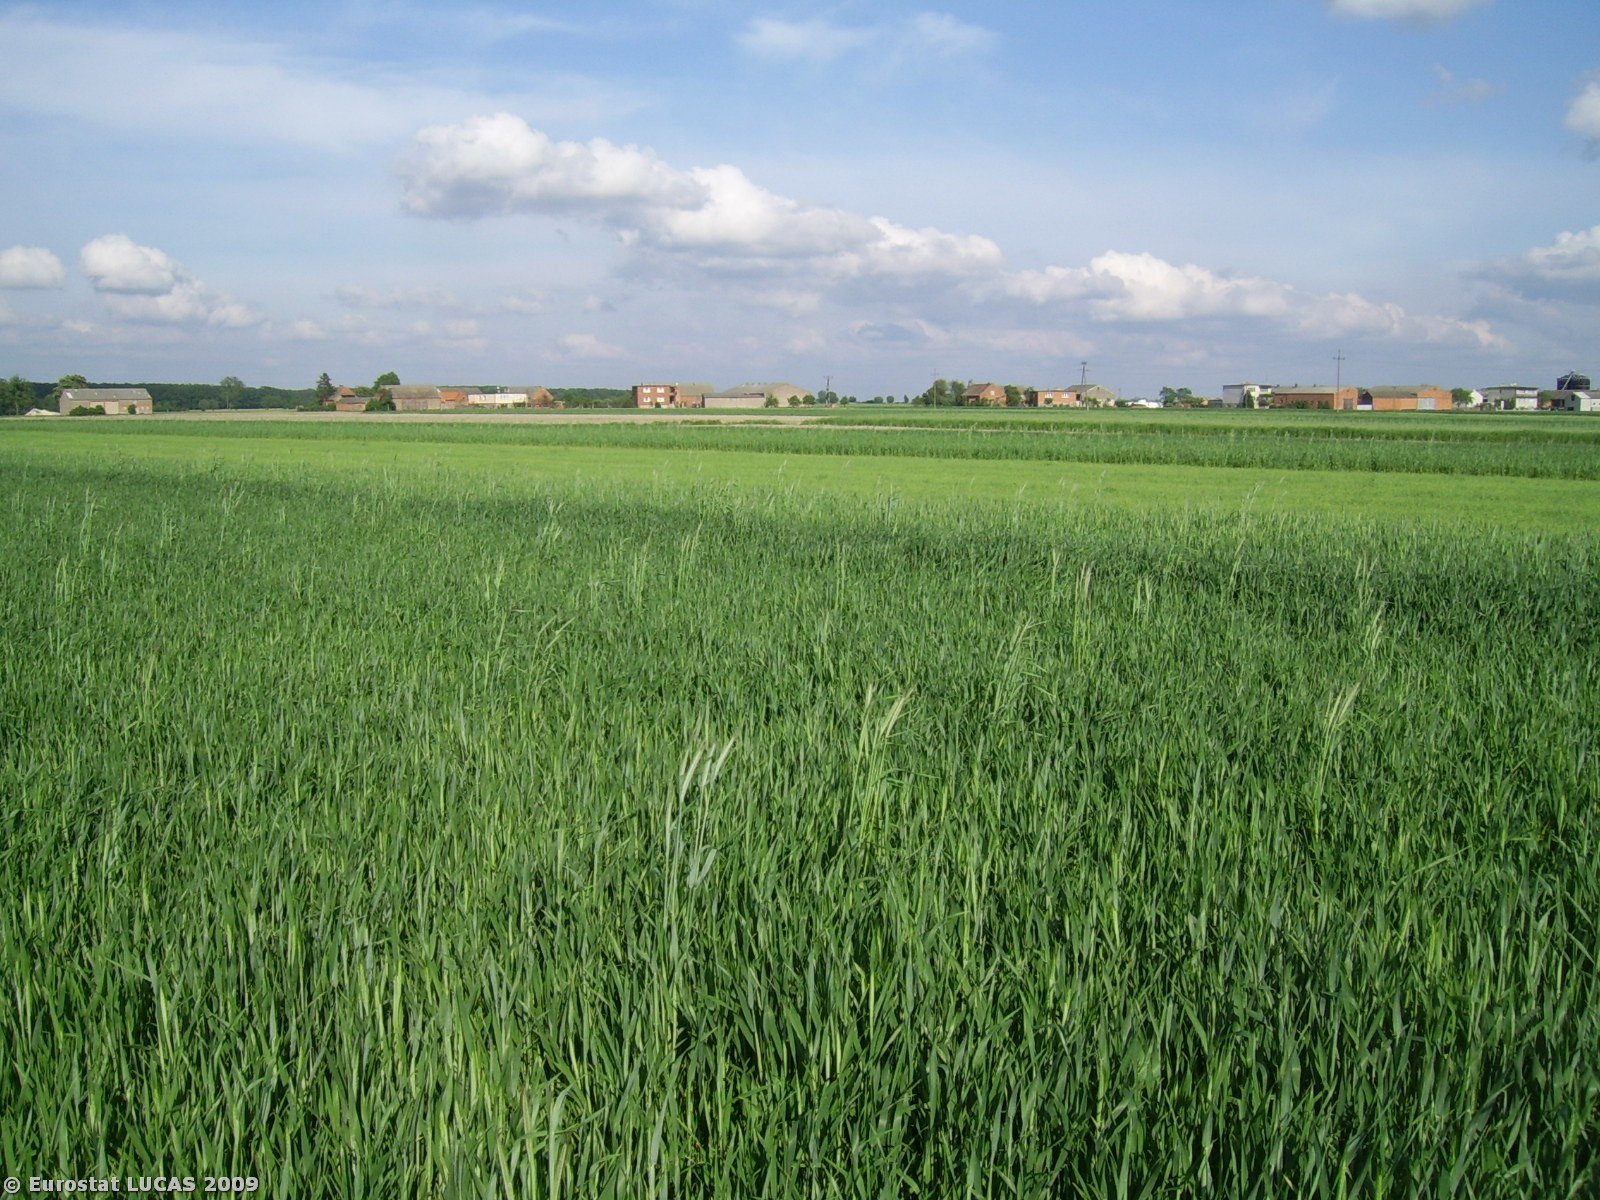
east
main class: Cropland
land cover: Triticale
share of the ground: > 75 %
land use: Agriculture (excluding fallow land and kitchen gardens)
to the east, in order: Triticale; Barley; Triticale; Grass margins; Sugar beet; Grass margins; Sugar beet; Grass margins; Sugar beet; Grass margins; Common wheat
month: May
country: PL
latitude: 51.8533
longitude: 16.8766
